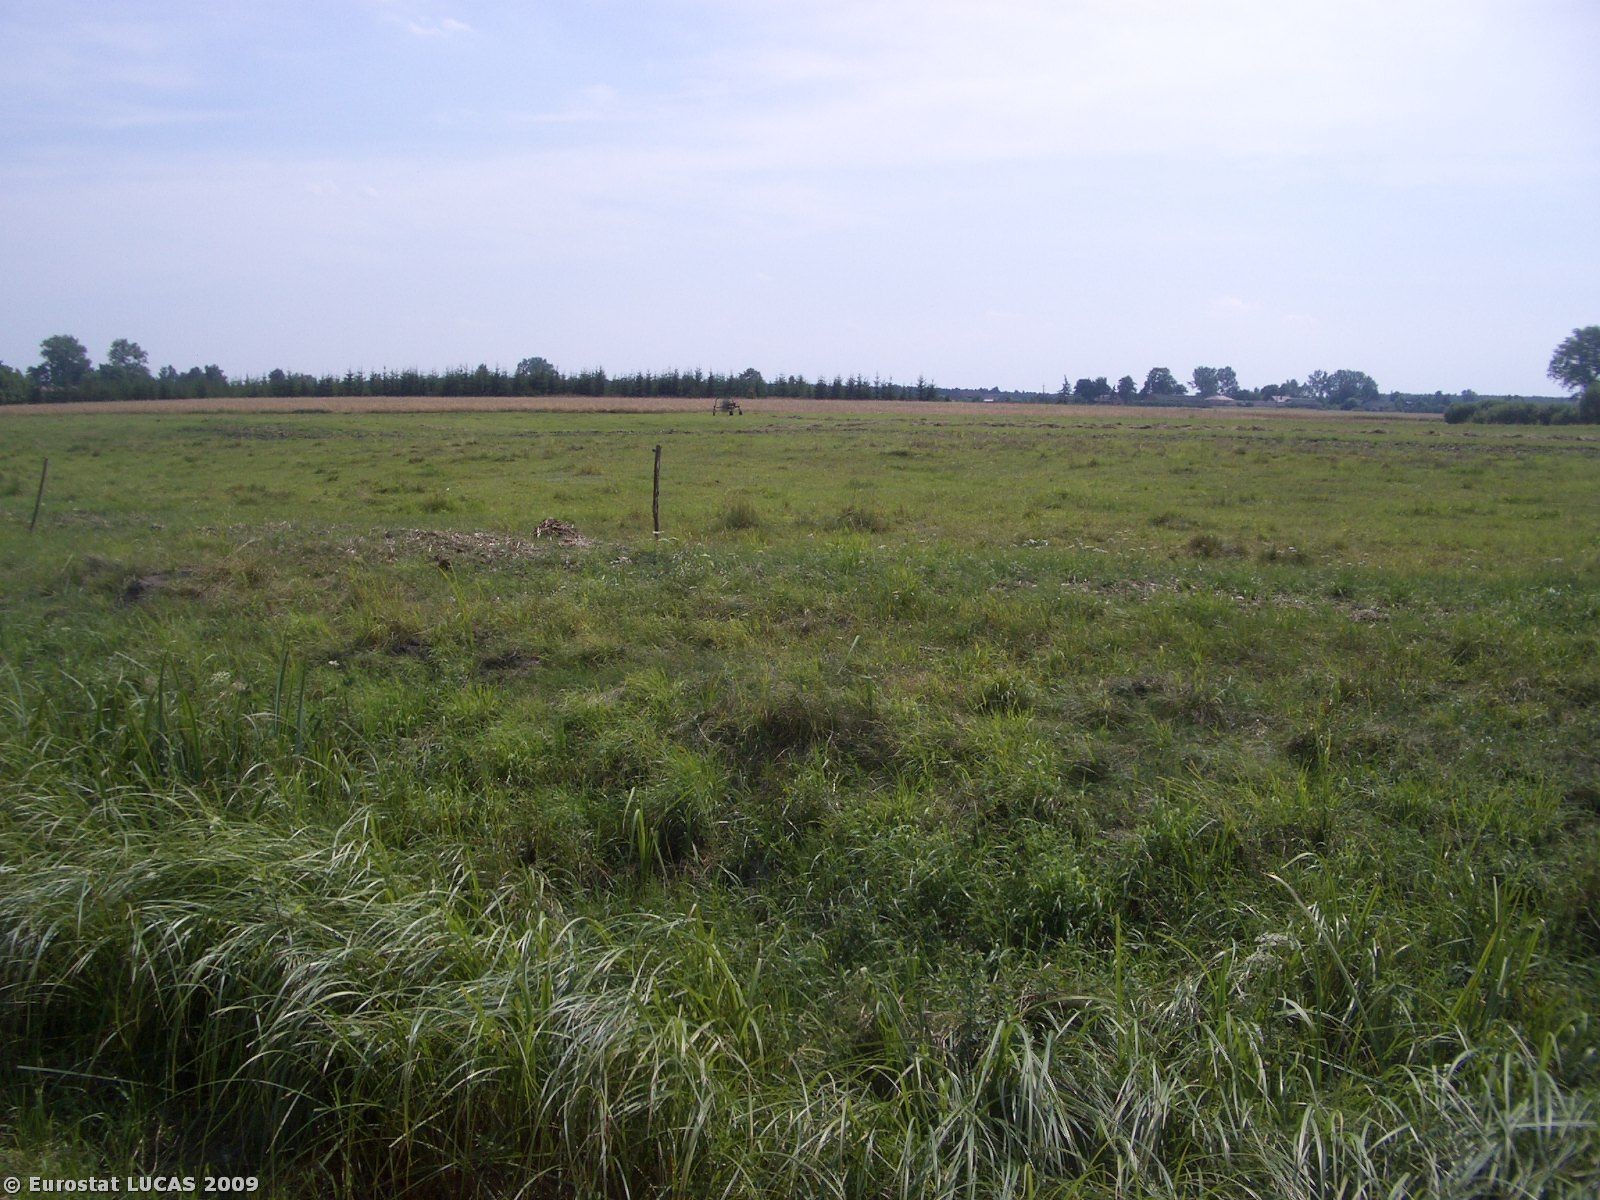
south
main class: Grassland
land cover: Grassland without tree/shrub cover
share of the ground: > 75 %
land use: Agriculture (excluding fallow land and kitchen gardens)
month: July
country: PL
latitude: 51.4471
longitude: 23.0988
